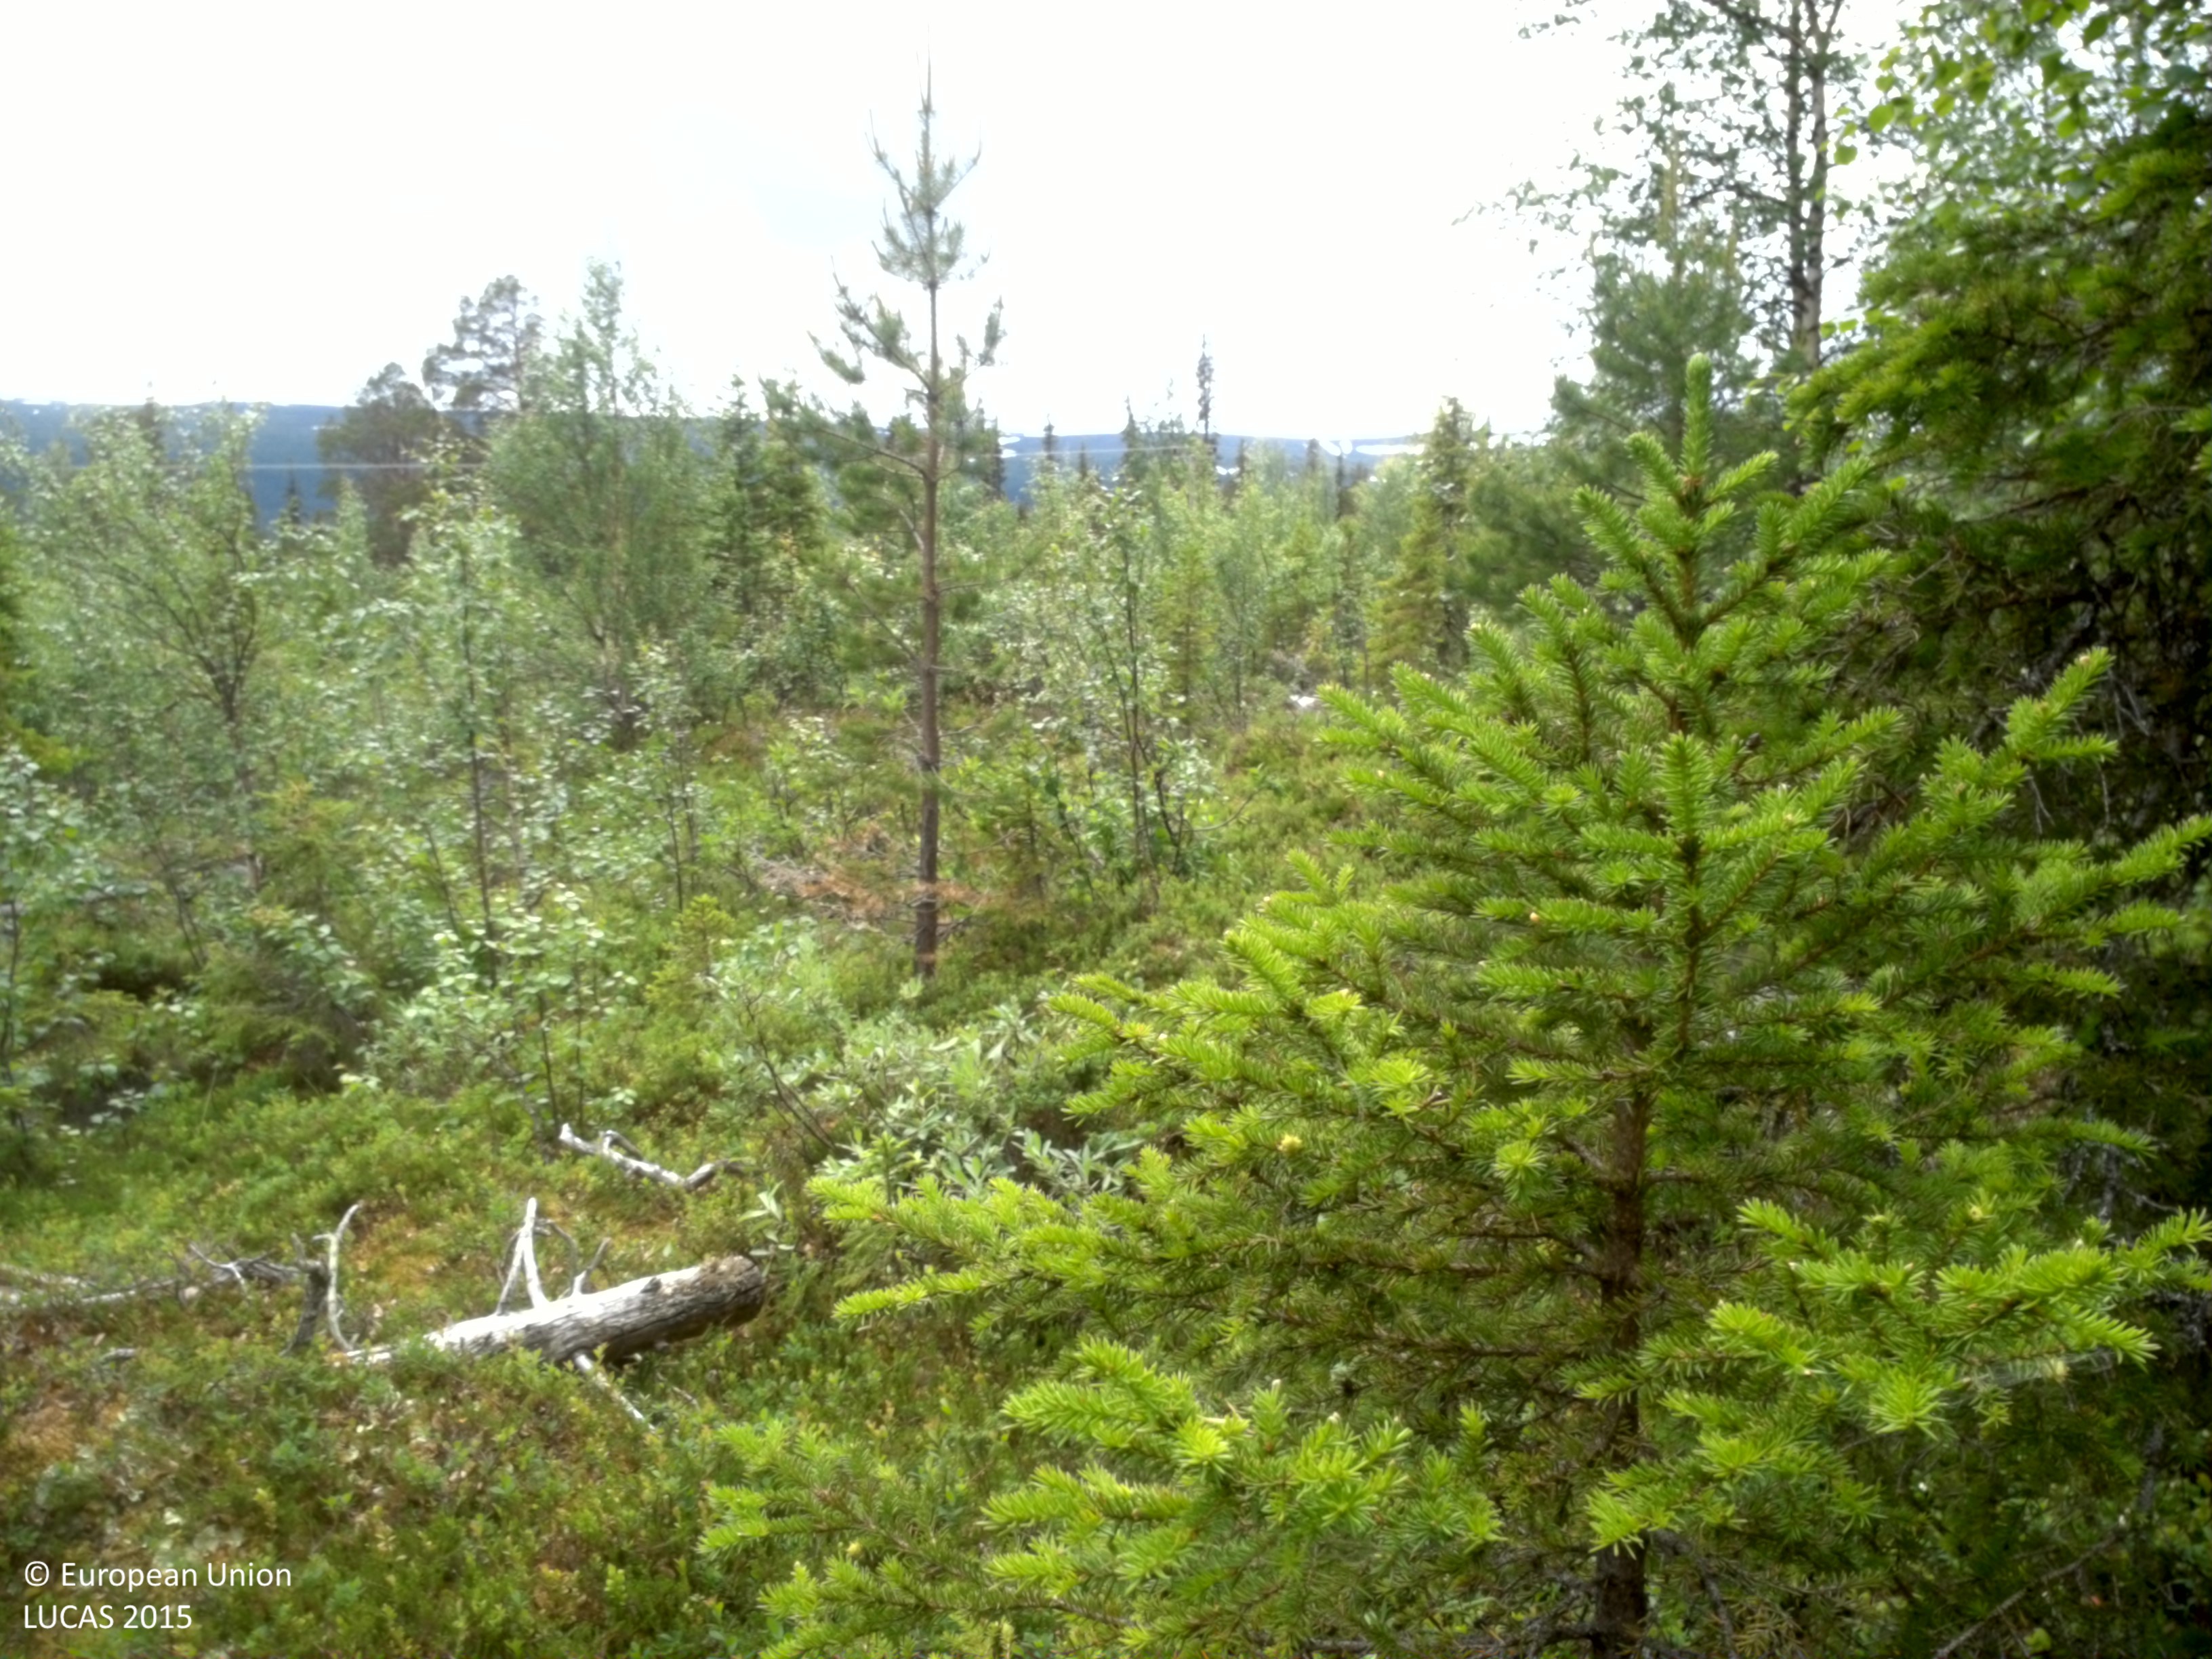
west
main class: Woodland
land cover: Spruce dominated mixed woodland
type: boreal forest
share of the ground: 50 - 75 %
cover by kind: coniferous forest trees 40 %, shrubs 35 %, broadleaved forest trees 20 %, lichens and mosses 5 %
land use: Forestry
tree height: > 5 m
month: July
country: SE
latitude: 67.3141
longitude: 18.9815
